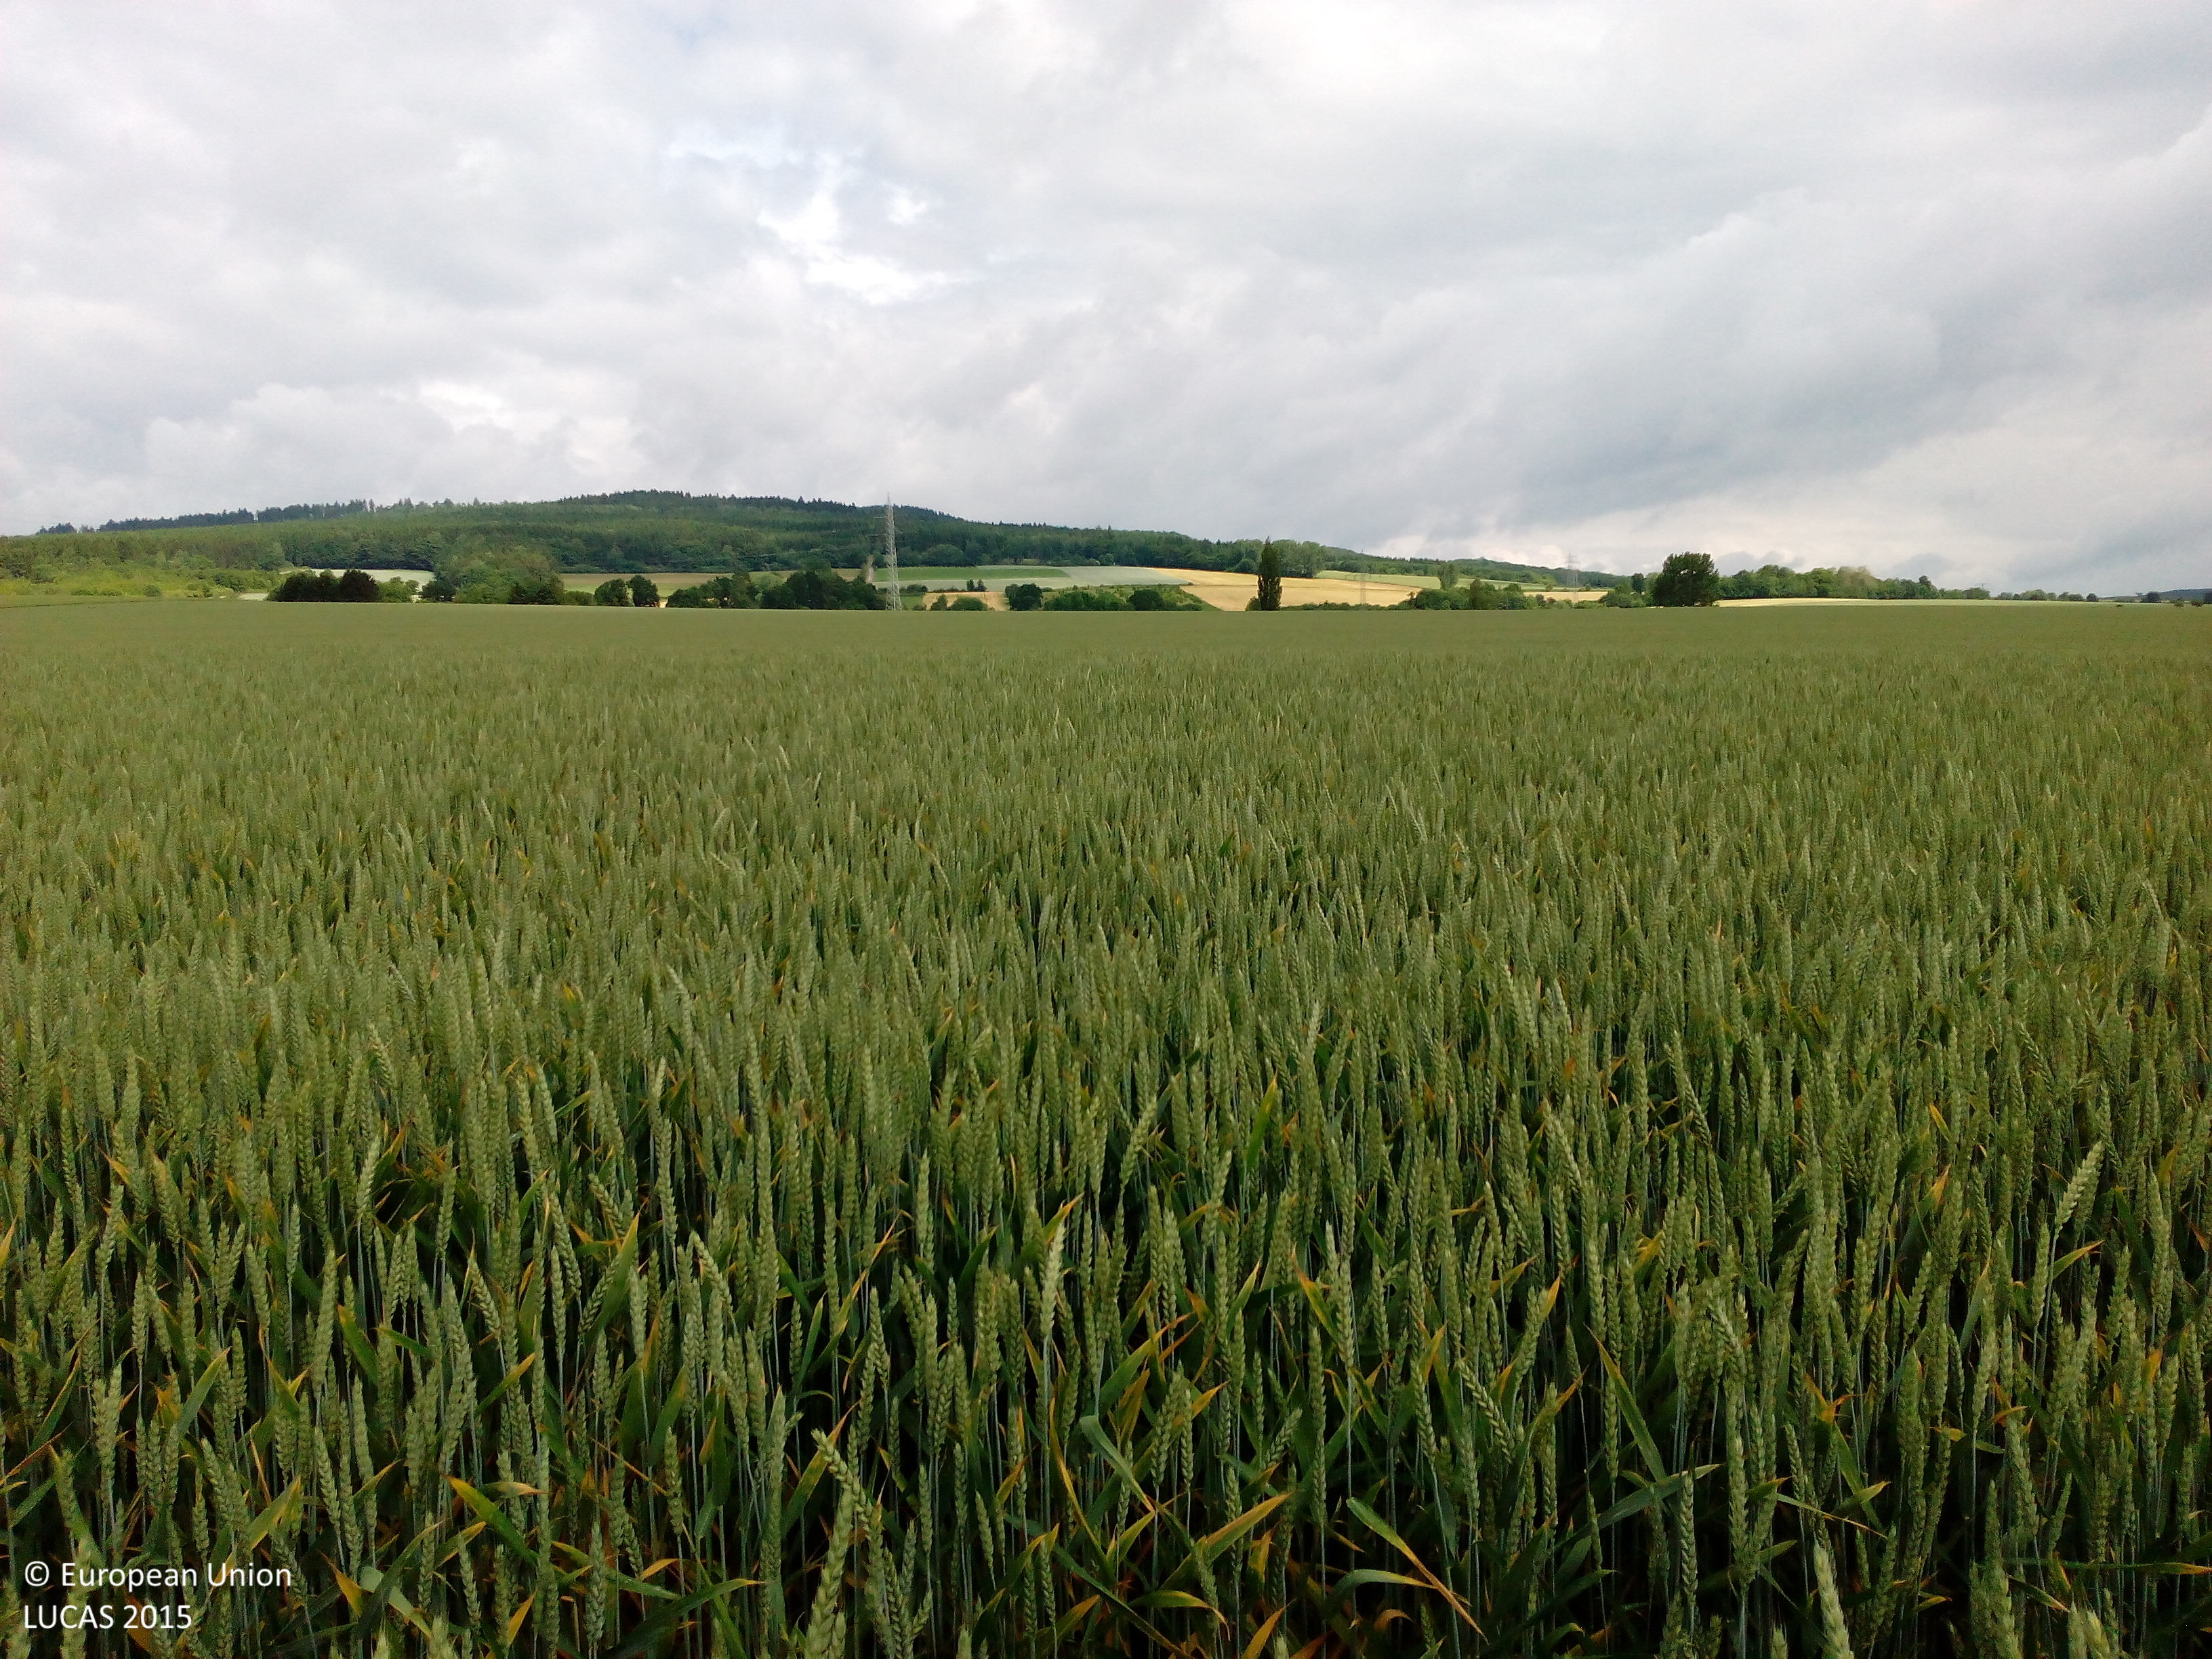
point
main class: Cropland
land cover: Common wheat
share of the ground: > 75 %
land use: Agriculture (excluding fallow land and kitchen gardens)
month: June
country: DE
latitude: 51.8741
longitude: 9.8403
